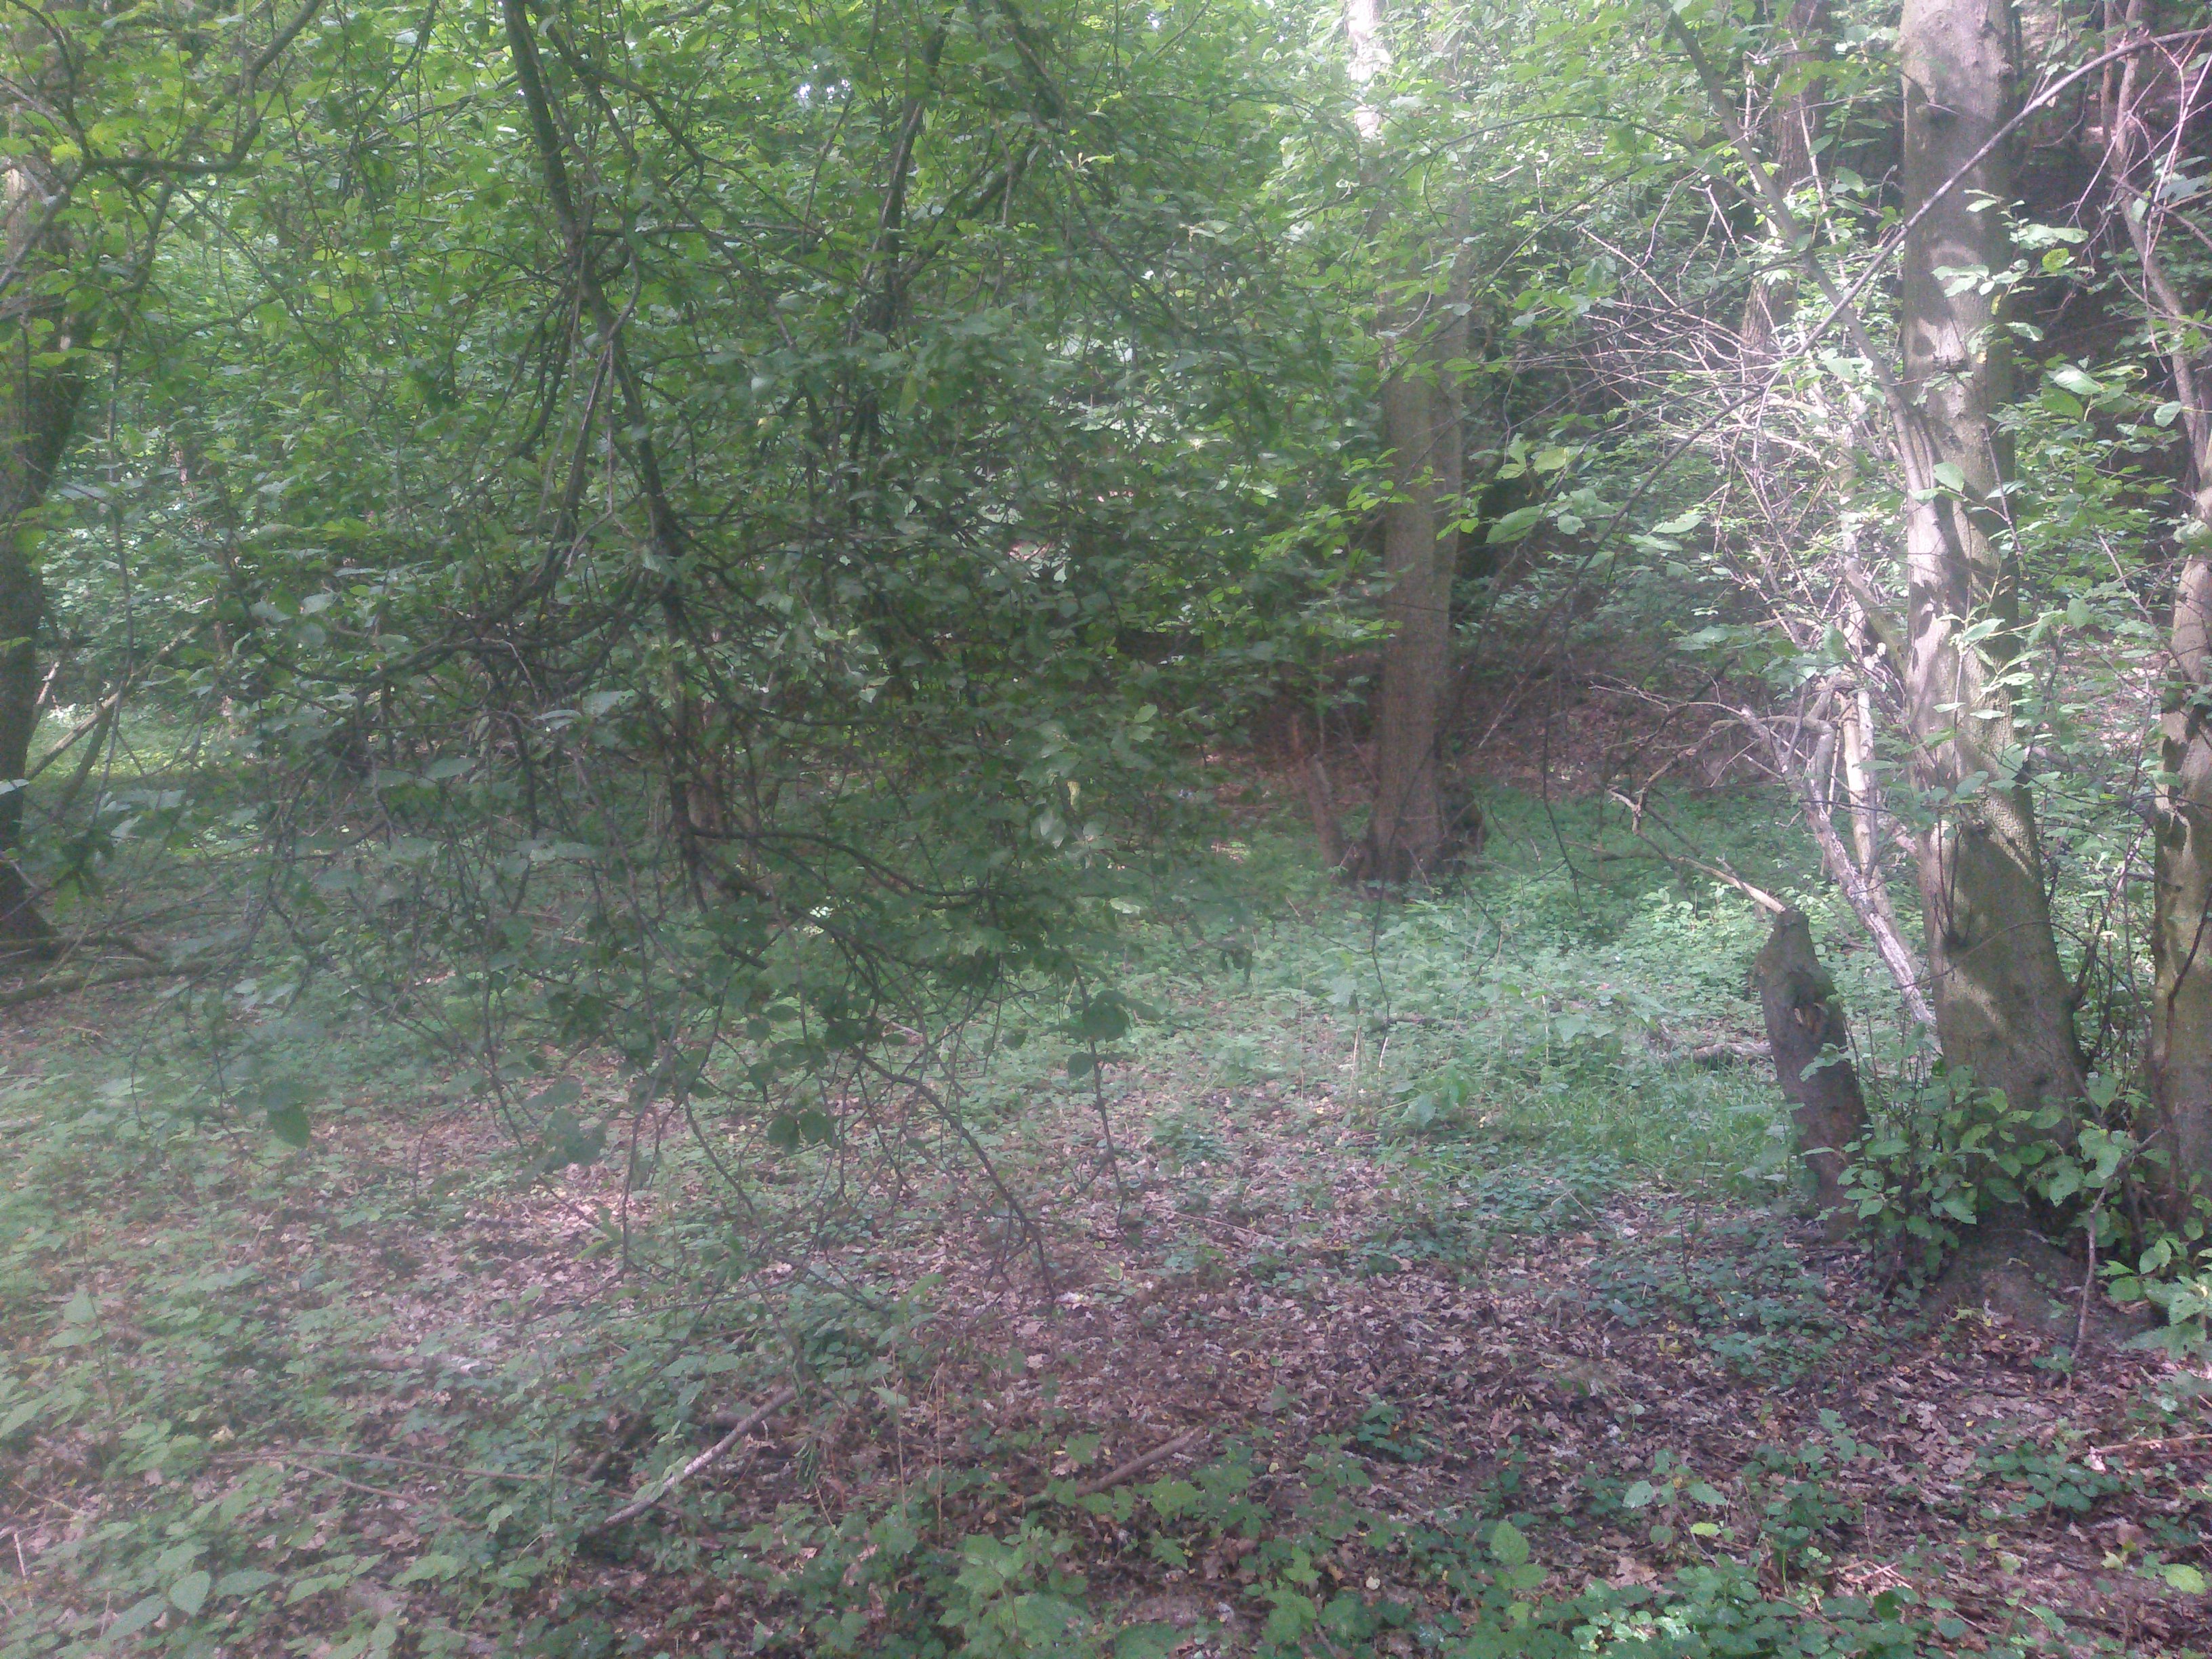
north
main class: Woodland
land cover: Broadleaved woodland
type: mesophytic deciduous forest
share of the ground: > 75 %
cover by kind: broadleaved forest trees 80 %, herbaceous plants 10 %, shrubs 5 %
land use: Forestry
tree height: > 5 m
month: May
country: PL
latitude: 50.3091
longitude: 17.6097
